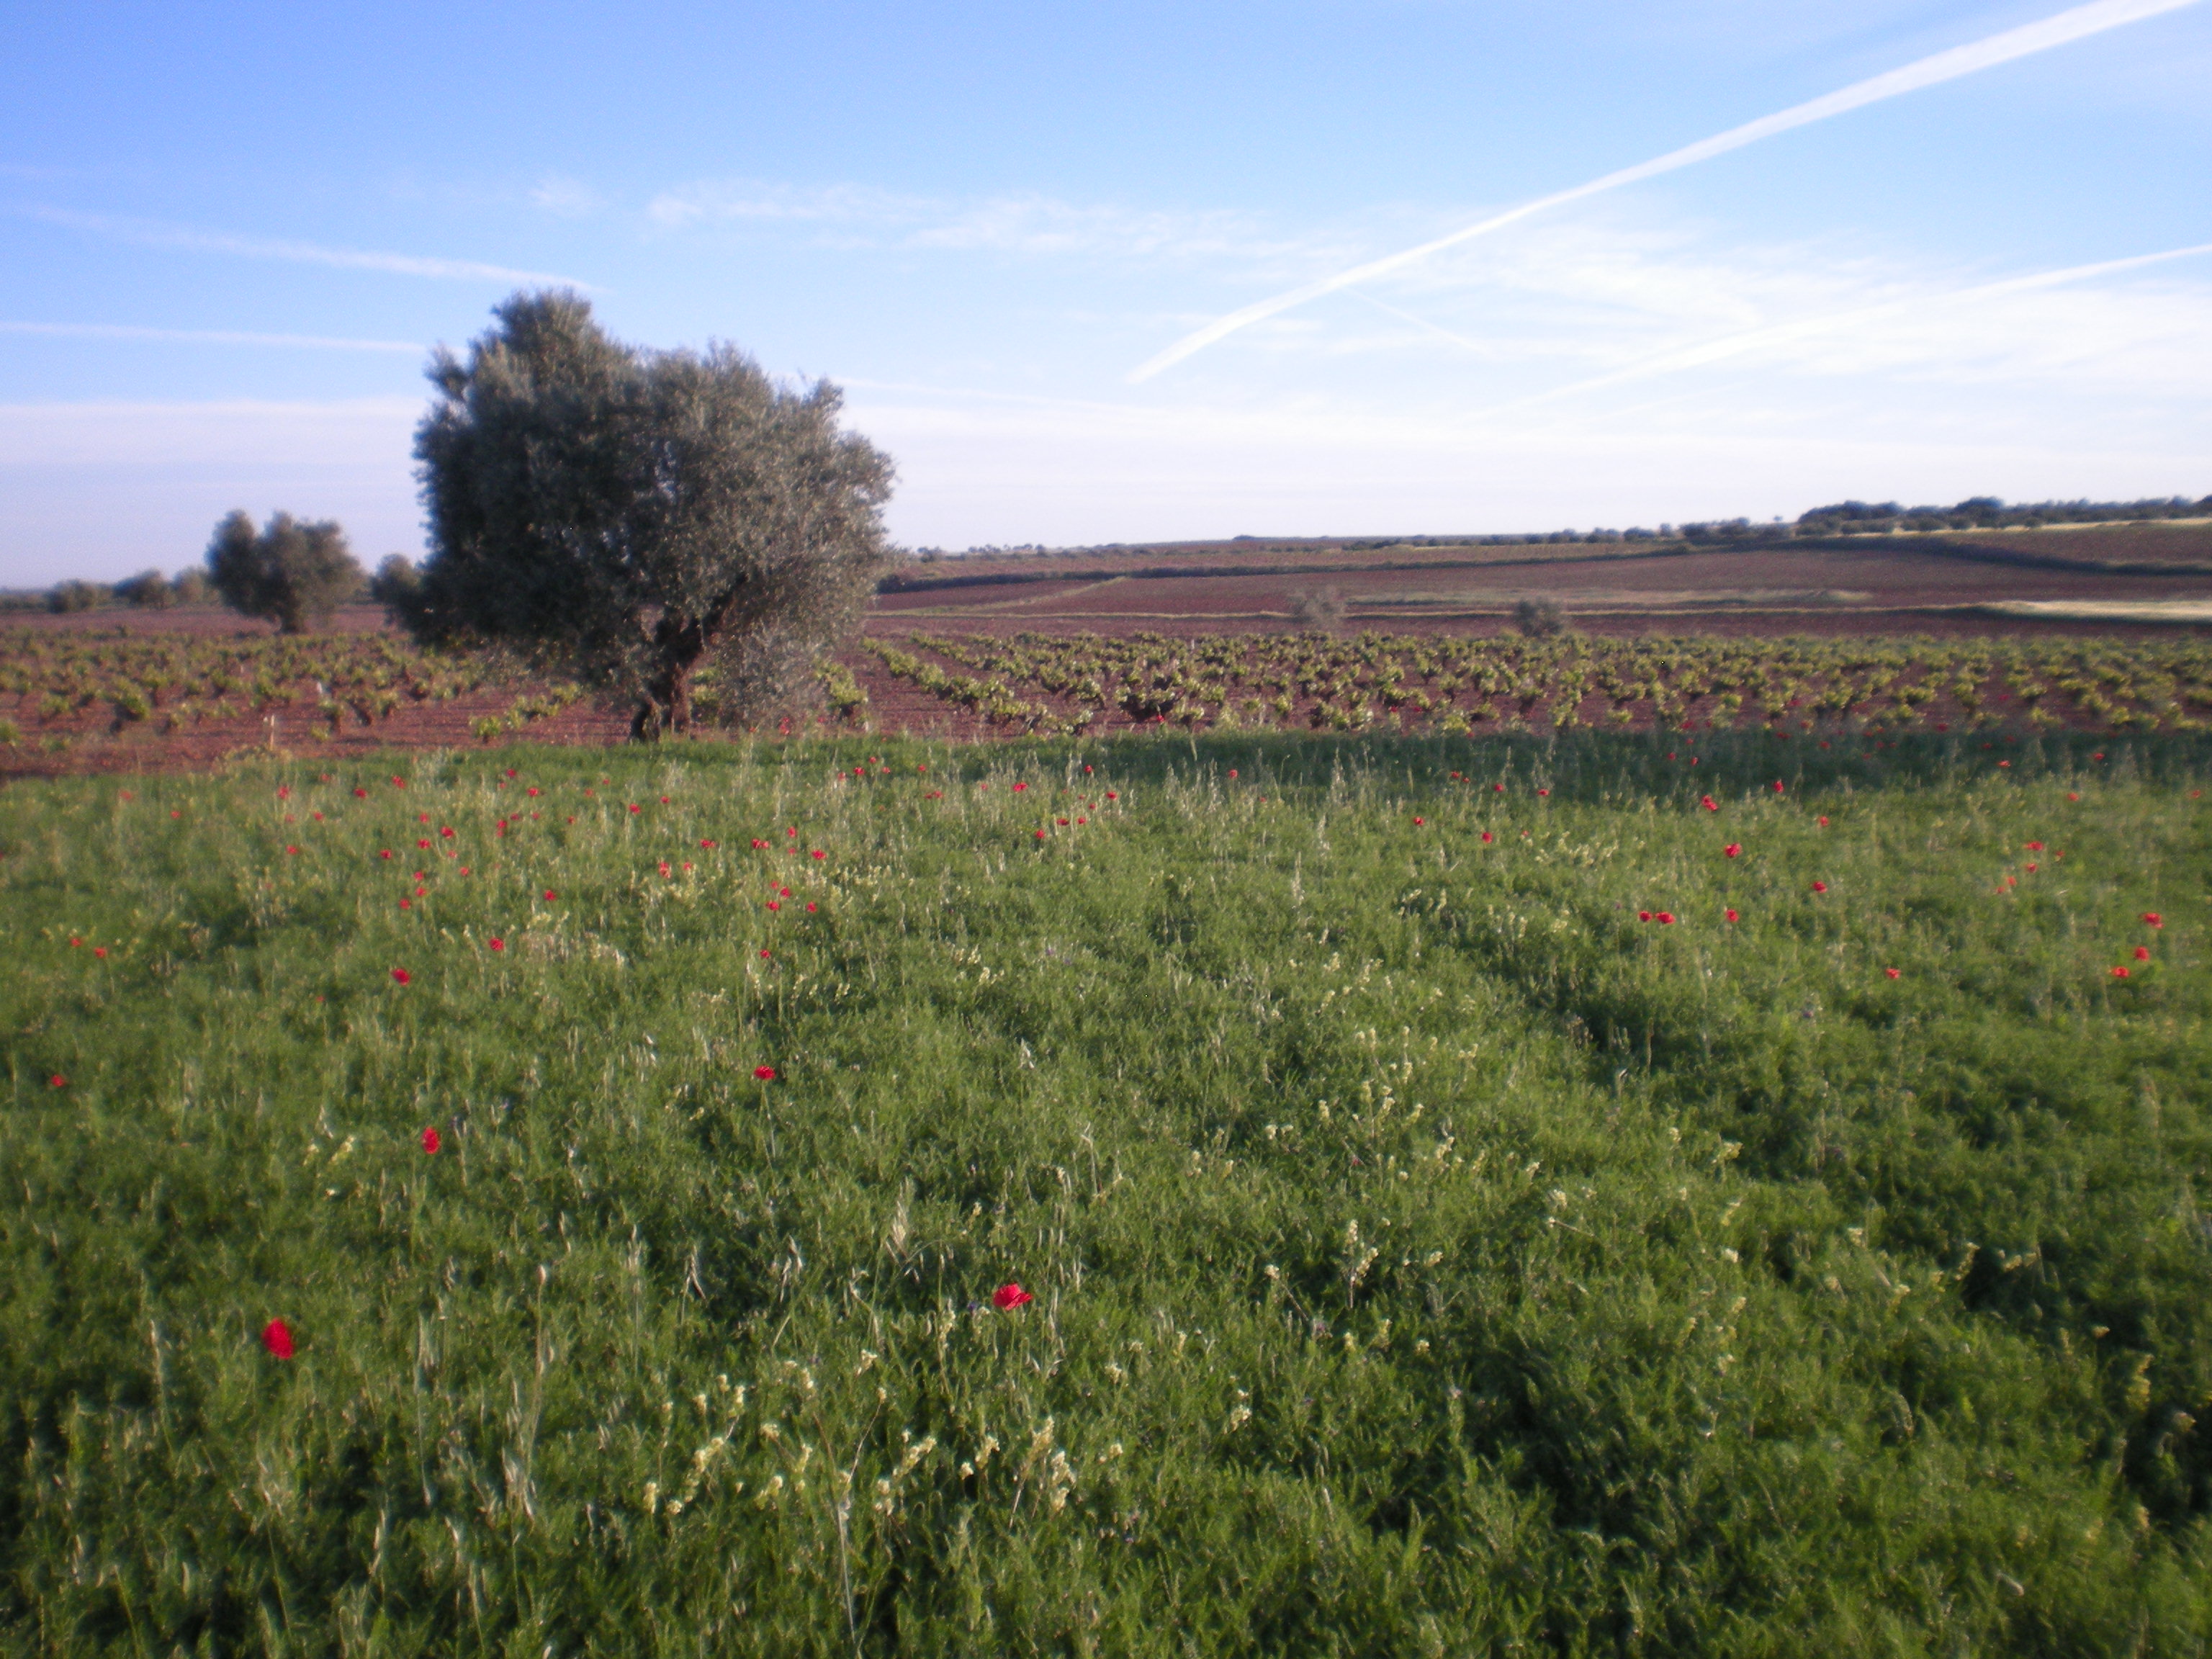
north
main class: Cropland
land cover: Dry pulses
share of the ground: > 75 %
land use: Agriculture (excluding fallow land and kitchen gardens)
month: May
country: ES
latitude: 38.9352
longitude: -3.1740
